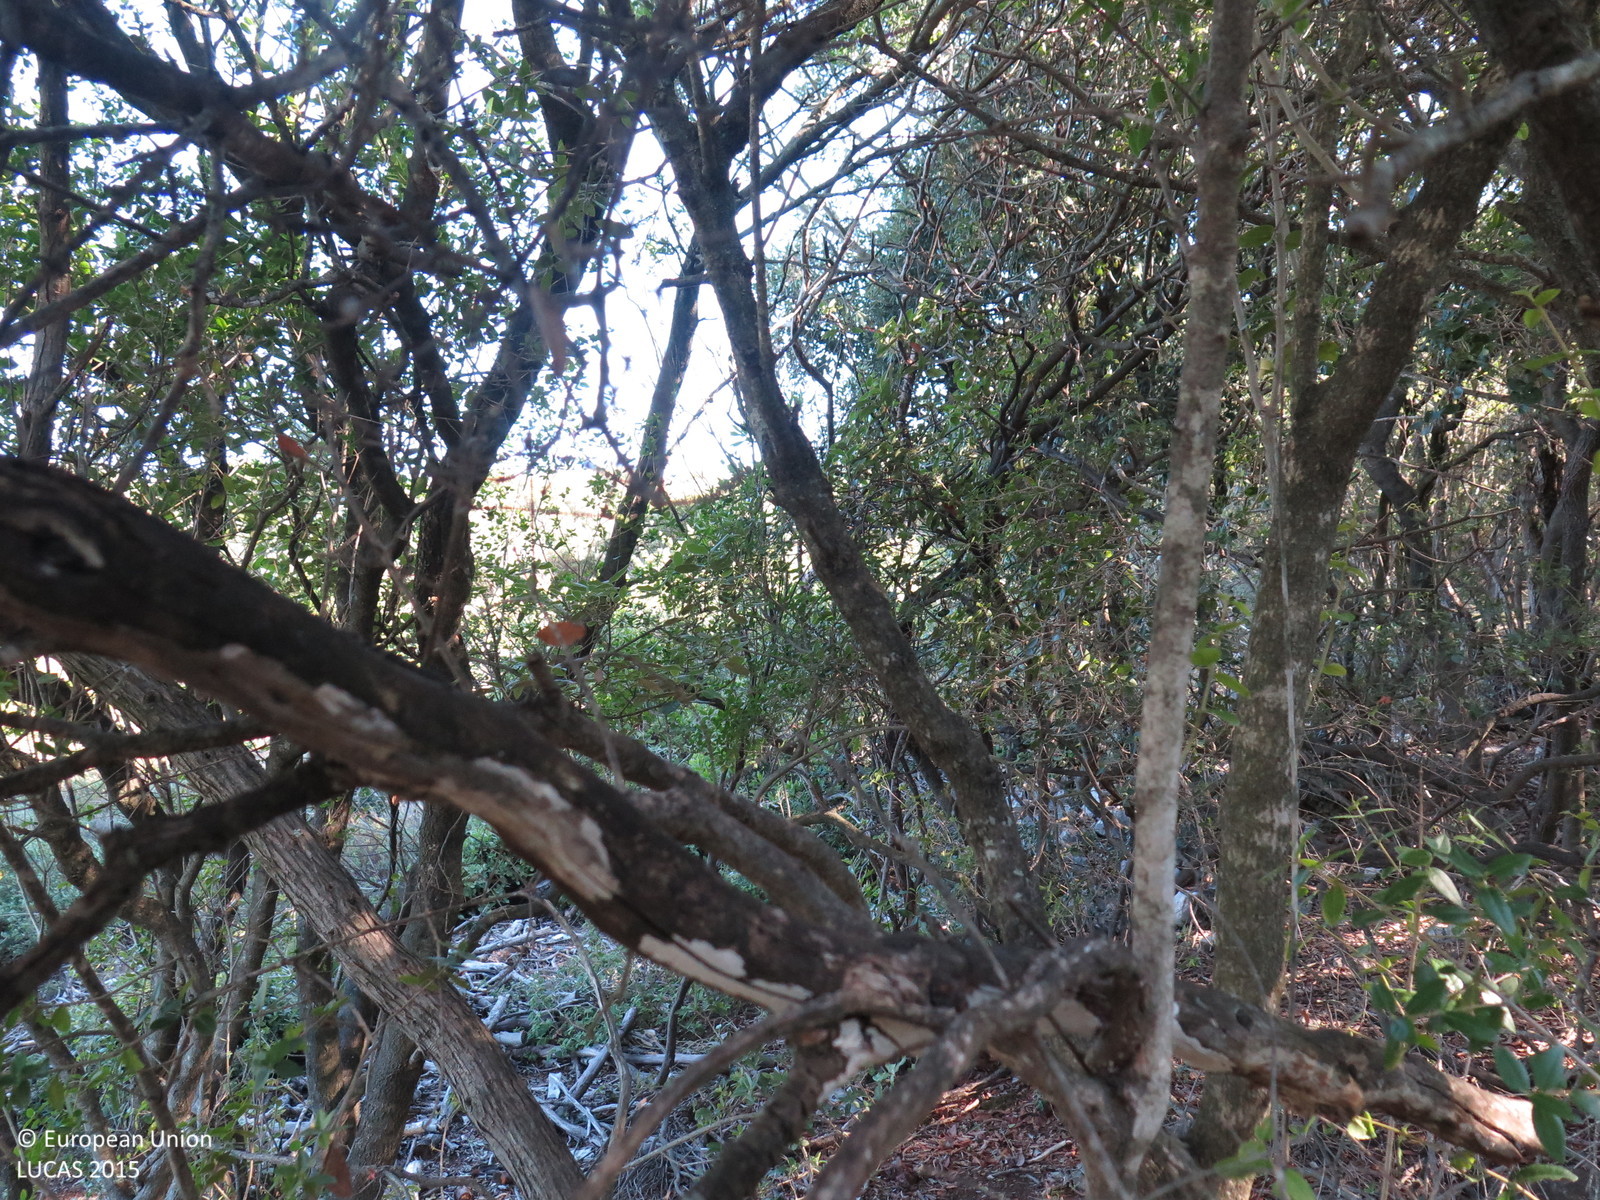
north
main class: Shrubland
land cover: Shrubland with sparse tree cover
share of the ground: > 75 %
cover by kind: shrubs 90 %, broadleaved forest trees 5 %, unconsolidated bare surface 5 %
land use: Semi-natural and natural areas not in use
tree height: > 5 m
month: September
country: HR
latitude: 44.5817
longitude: 14.4139
